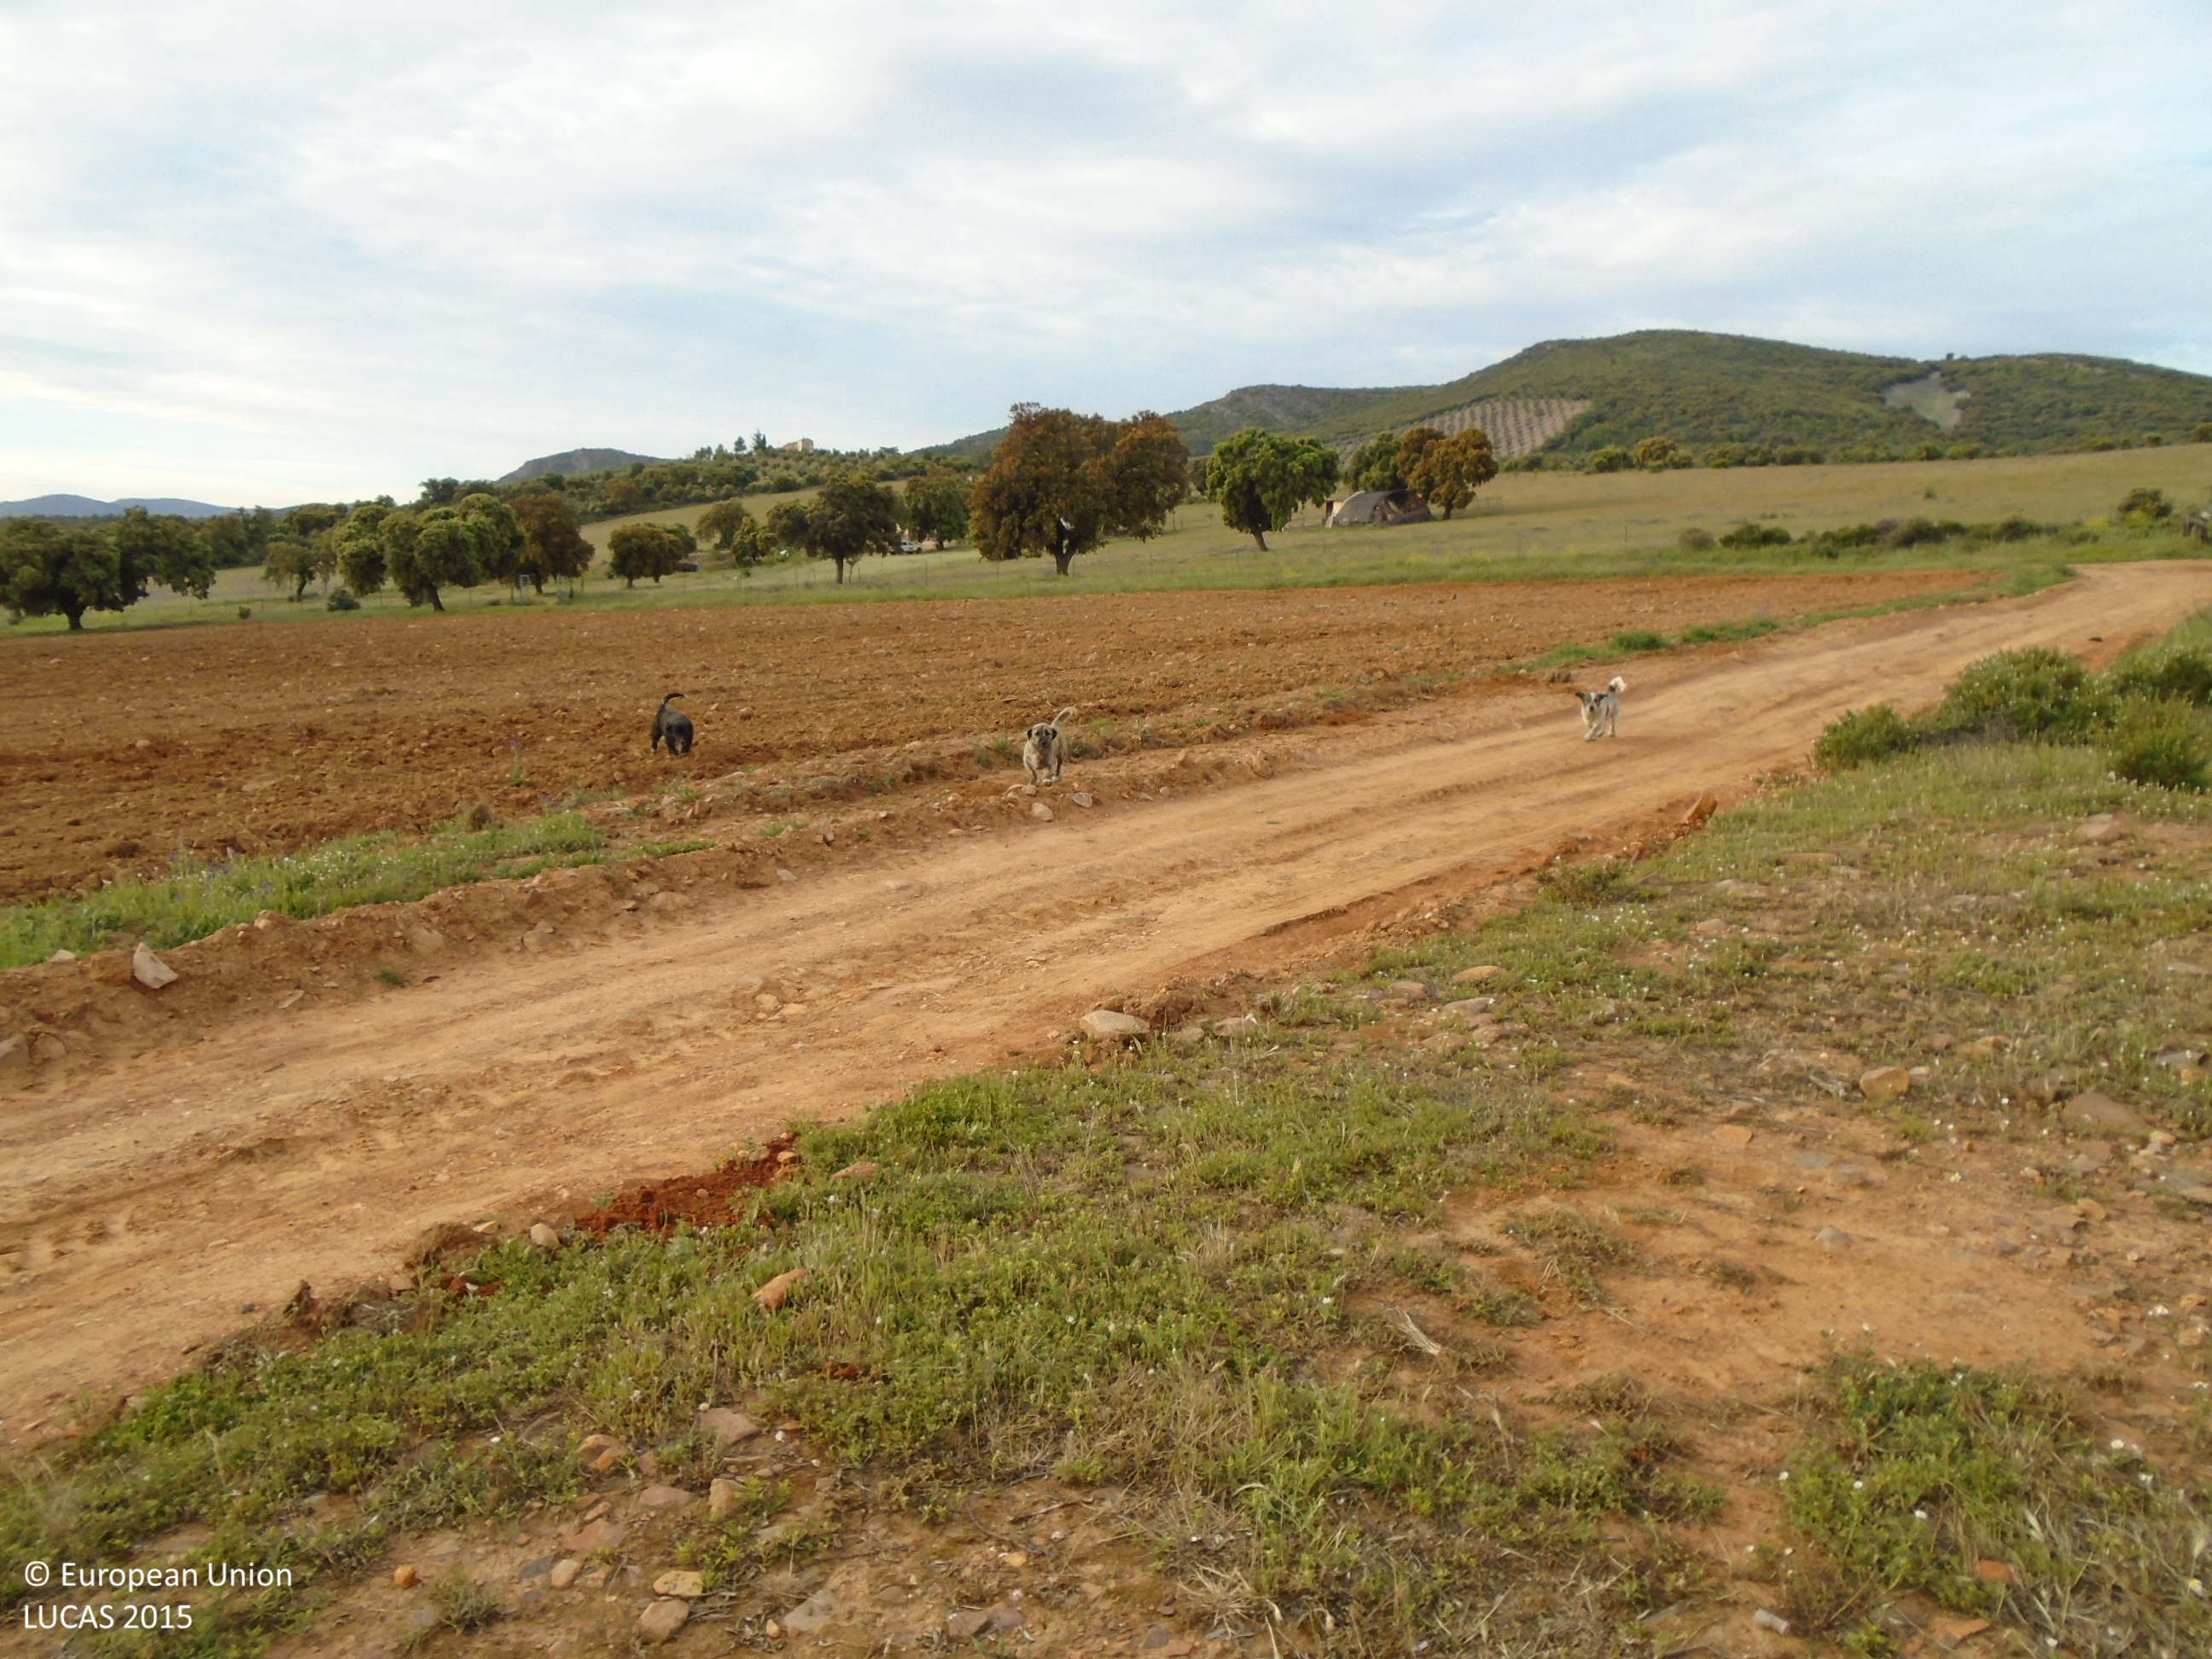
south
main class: Cropland
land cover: Olive groves
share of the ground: 10 - 25 %
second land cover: Other bare soil
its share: > 75 %
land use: Agriculture (excluding fallow land and kitchen gardens)
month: May
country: ES
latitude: 39.6821
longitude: -4.6027
